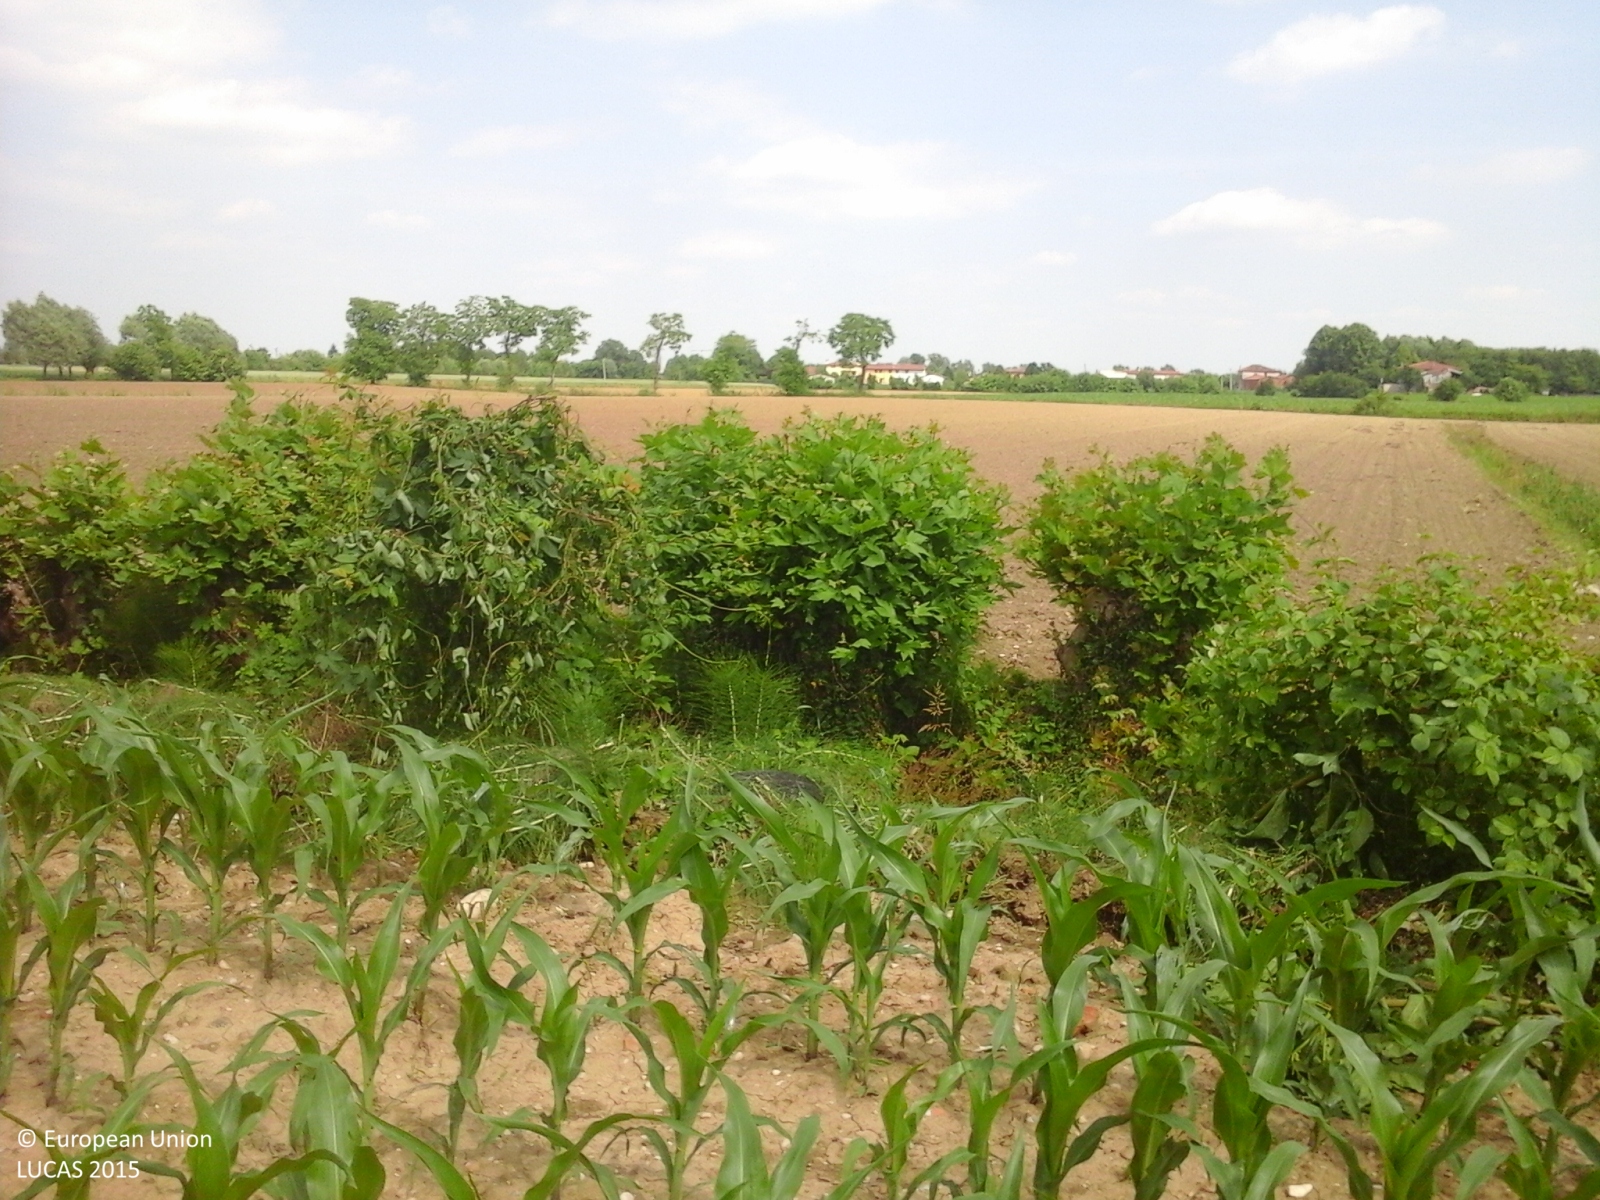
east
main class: Cropland
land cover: Maize
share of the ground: 25 - 50 %
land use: Agriculture (excluding fallow land and kitchen gardens)
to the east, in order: Maize; Managed hedges; Ditches and canals; Managed hedges; Maize; Ditches and canals; Abandoned hedges; Maize; Ditches and canals; Grassland without tree/shrub cover
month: May
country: IT
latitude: 45.6188
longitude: 11.5749
